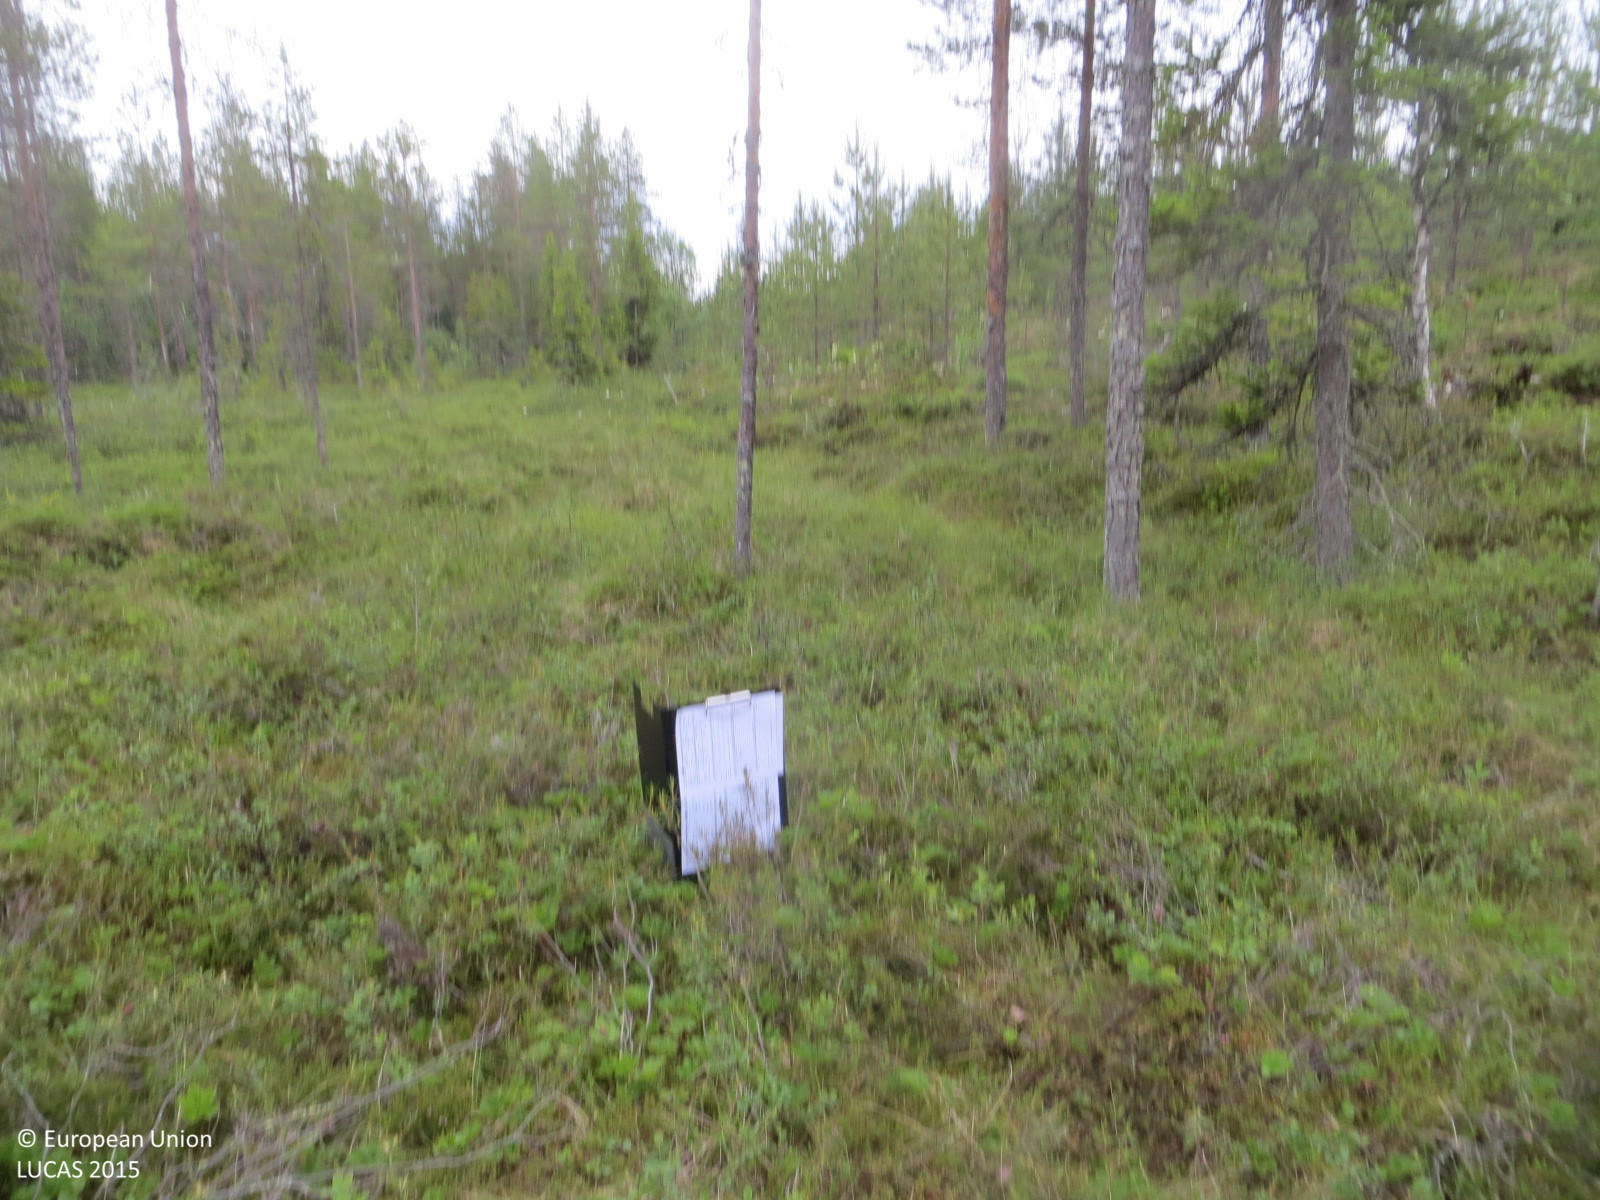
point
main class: Woodland
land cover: Pine dominated coniferous woodland
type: boreal forest
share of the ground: 25 - 50 %
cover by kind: shrubs 50 %, coniferous forest trees 40 %, lichens and mosses 10 %
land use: Forestry
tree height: > 5 m
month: June
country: FI
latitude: 65.4344
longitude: 26.1536
